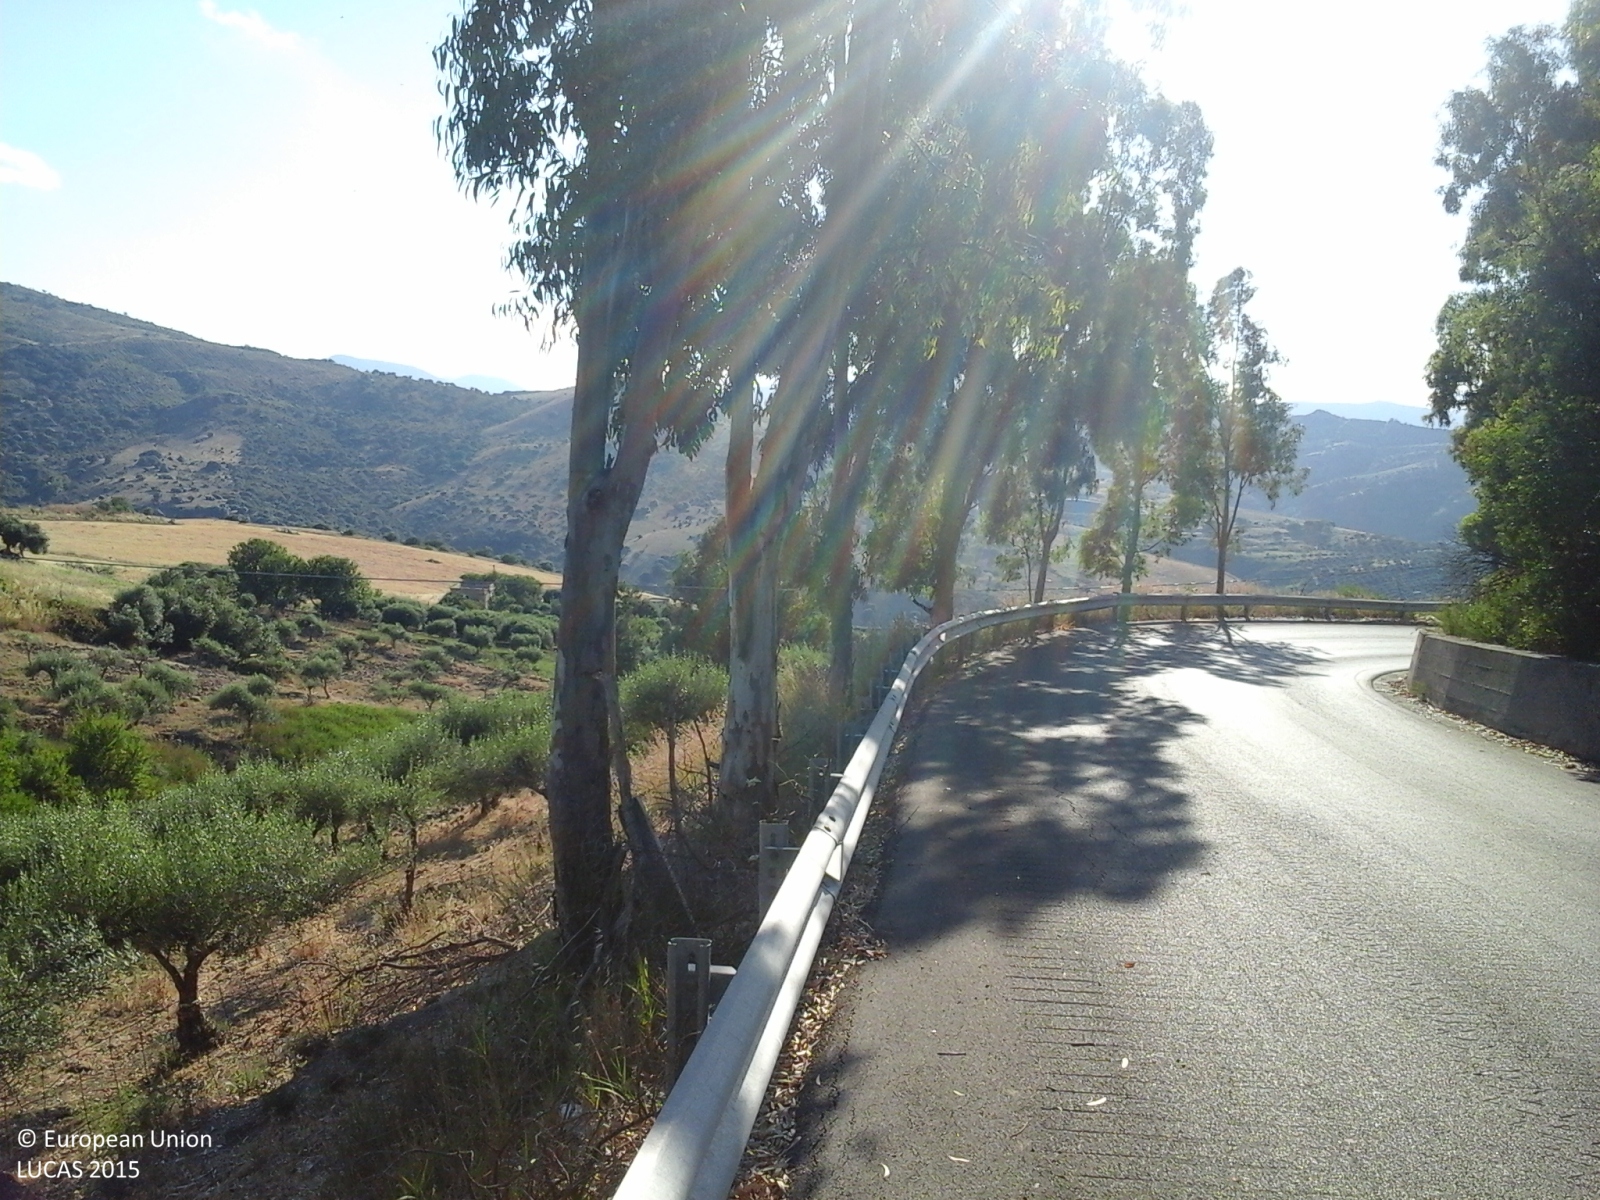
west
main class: Cropland
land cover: Olive groves
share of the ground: 50 - 75 %
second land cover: Other bare soil
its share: > 75 %
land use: Agriculture (excluding fallow land and kitchen gardens)
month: June
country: IT
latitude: 37.9913
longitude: 13.5163
